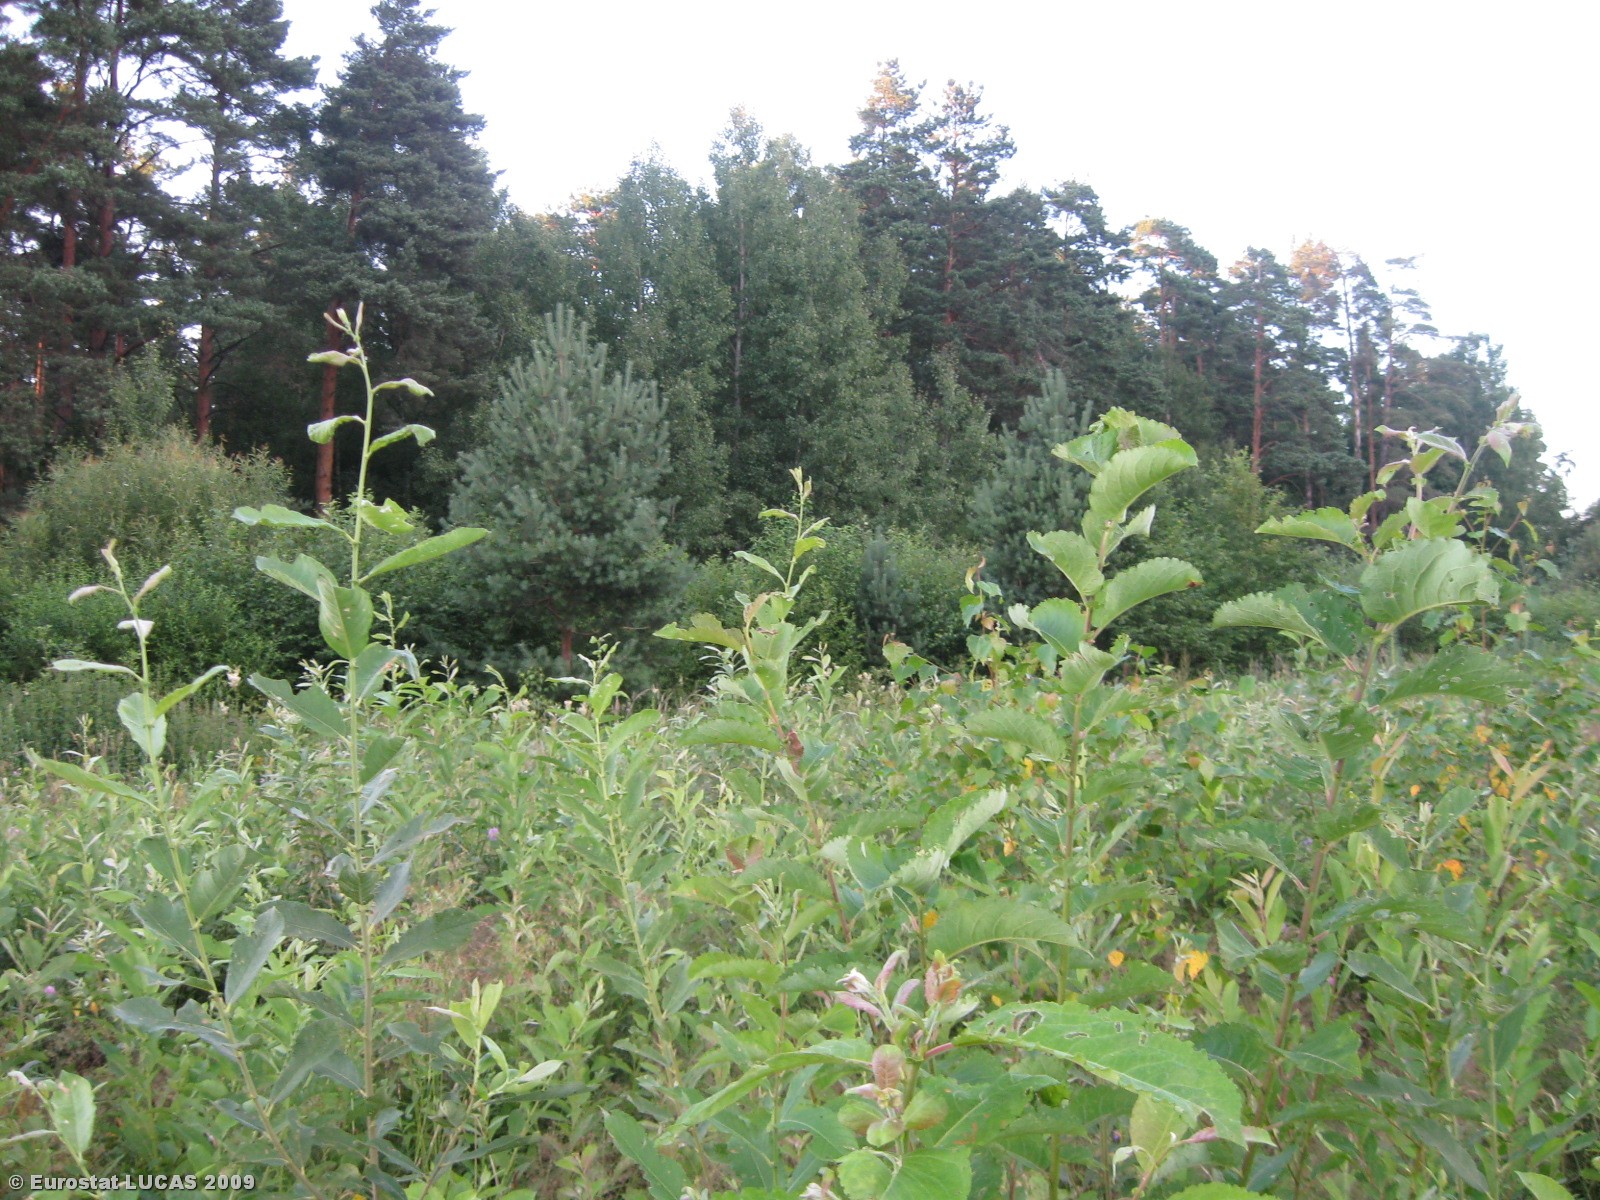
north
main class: Grassland
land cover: Grassland with sparse tree/shrub cover
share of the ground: > 75 %
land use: Forestry
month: July
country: LT
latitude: 54.5799
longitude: 25.3314
